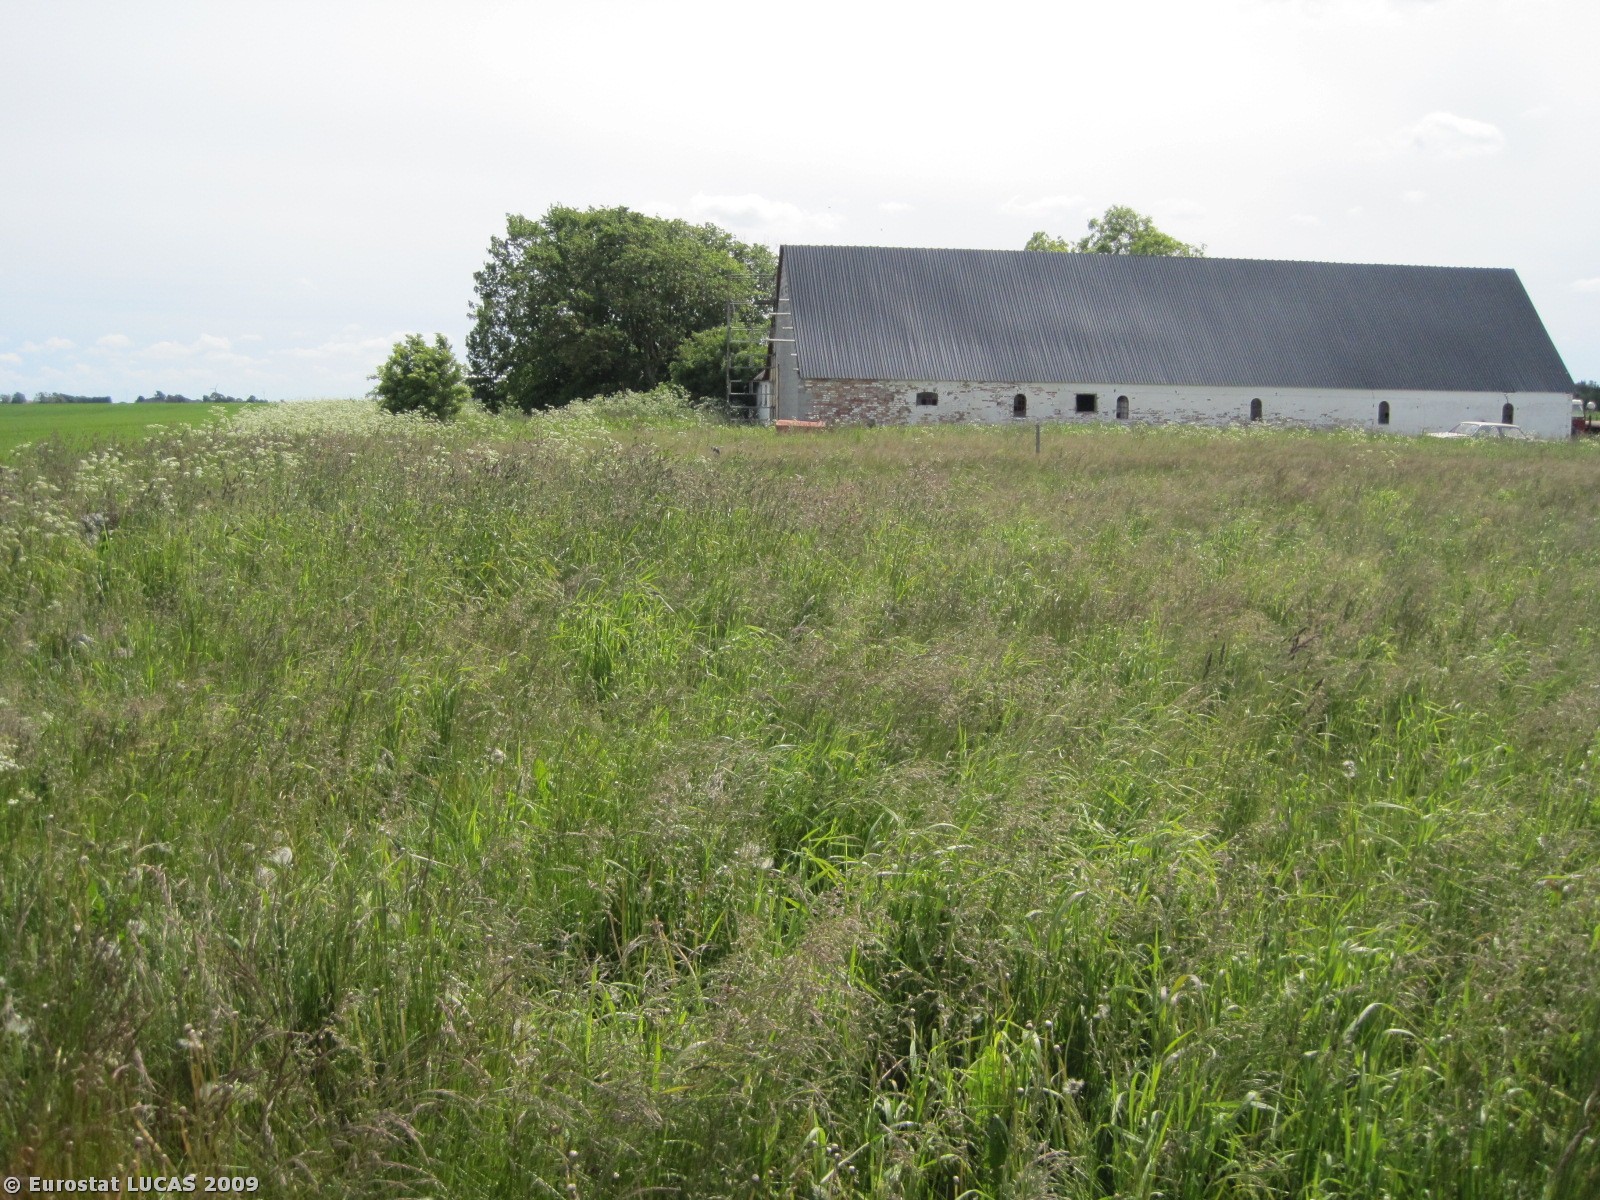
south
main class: Grassland
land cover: Grassland without tree/shrub cover
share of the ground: > 75 %
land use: Unused
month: June
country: DK
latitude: 57.3742
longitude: 9.8838
